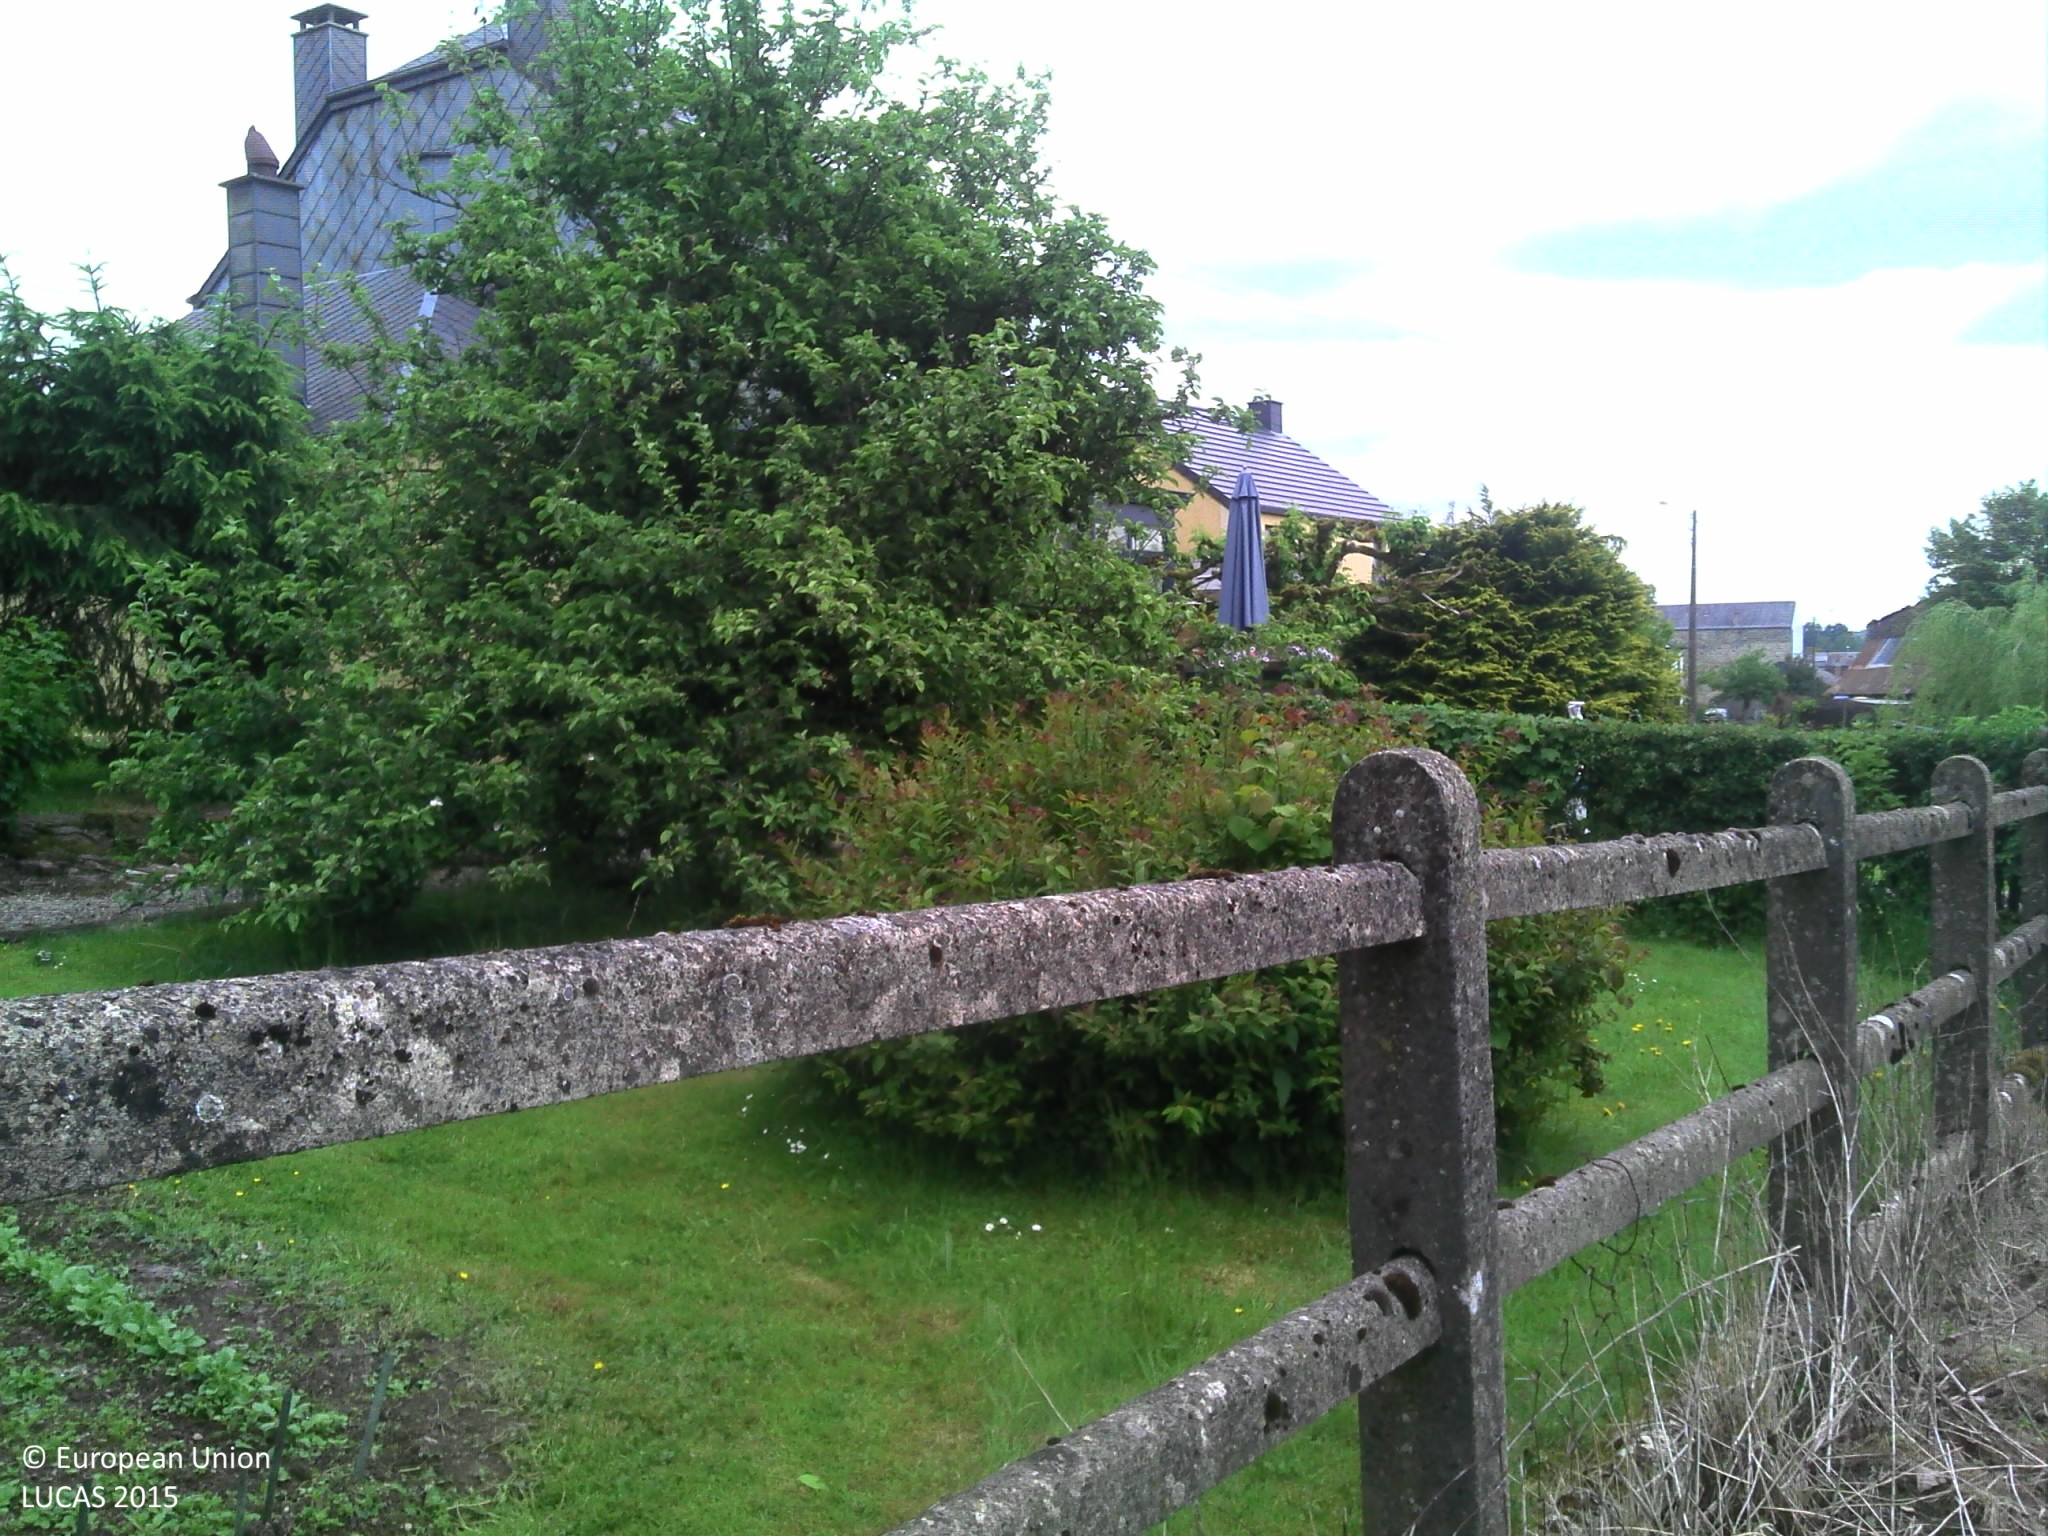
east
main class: Grassland
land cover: Grassland with sparse tree/shrub cover
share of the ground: > 75 %
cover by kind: herbaceous plants 90 %, broadleaved forest trees 5 %, unconsolidated bare surface 5 %
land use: Residential
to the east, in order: Fences; Artificial constructions in urban areas; Managed hedges; Spruce dominated coniferous woodland; Fences; Grassland without tree/shrub cover
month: June
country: BE
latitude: 49.8177
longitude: 4.8964
